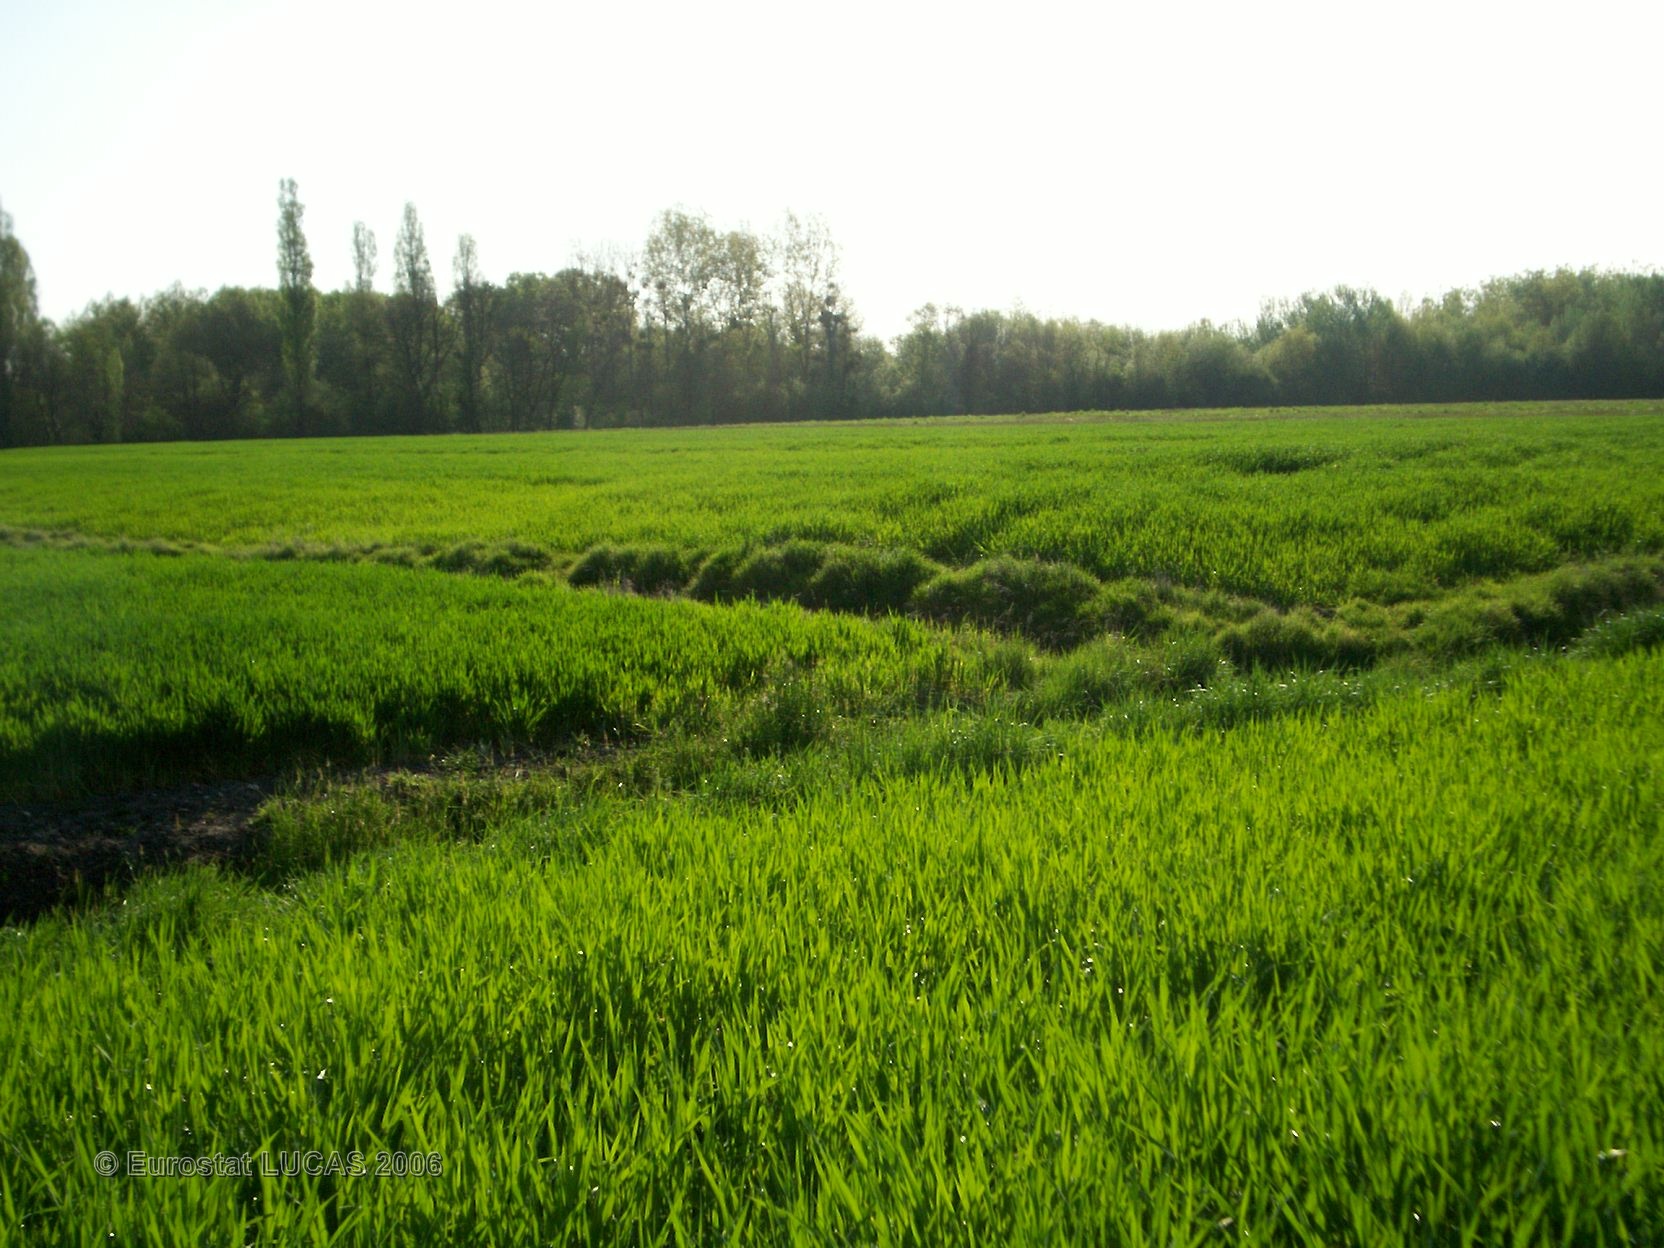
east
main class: Cropland
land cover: Barley
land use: Agriculture (excluding fallow land and kitchen gardens)
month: April
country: FR
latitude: 47.1016
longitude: 0.4534
